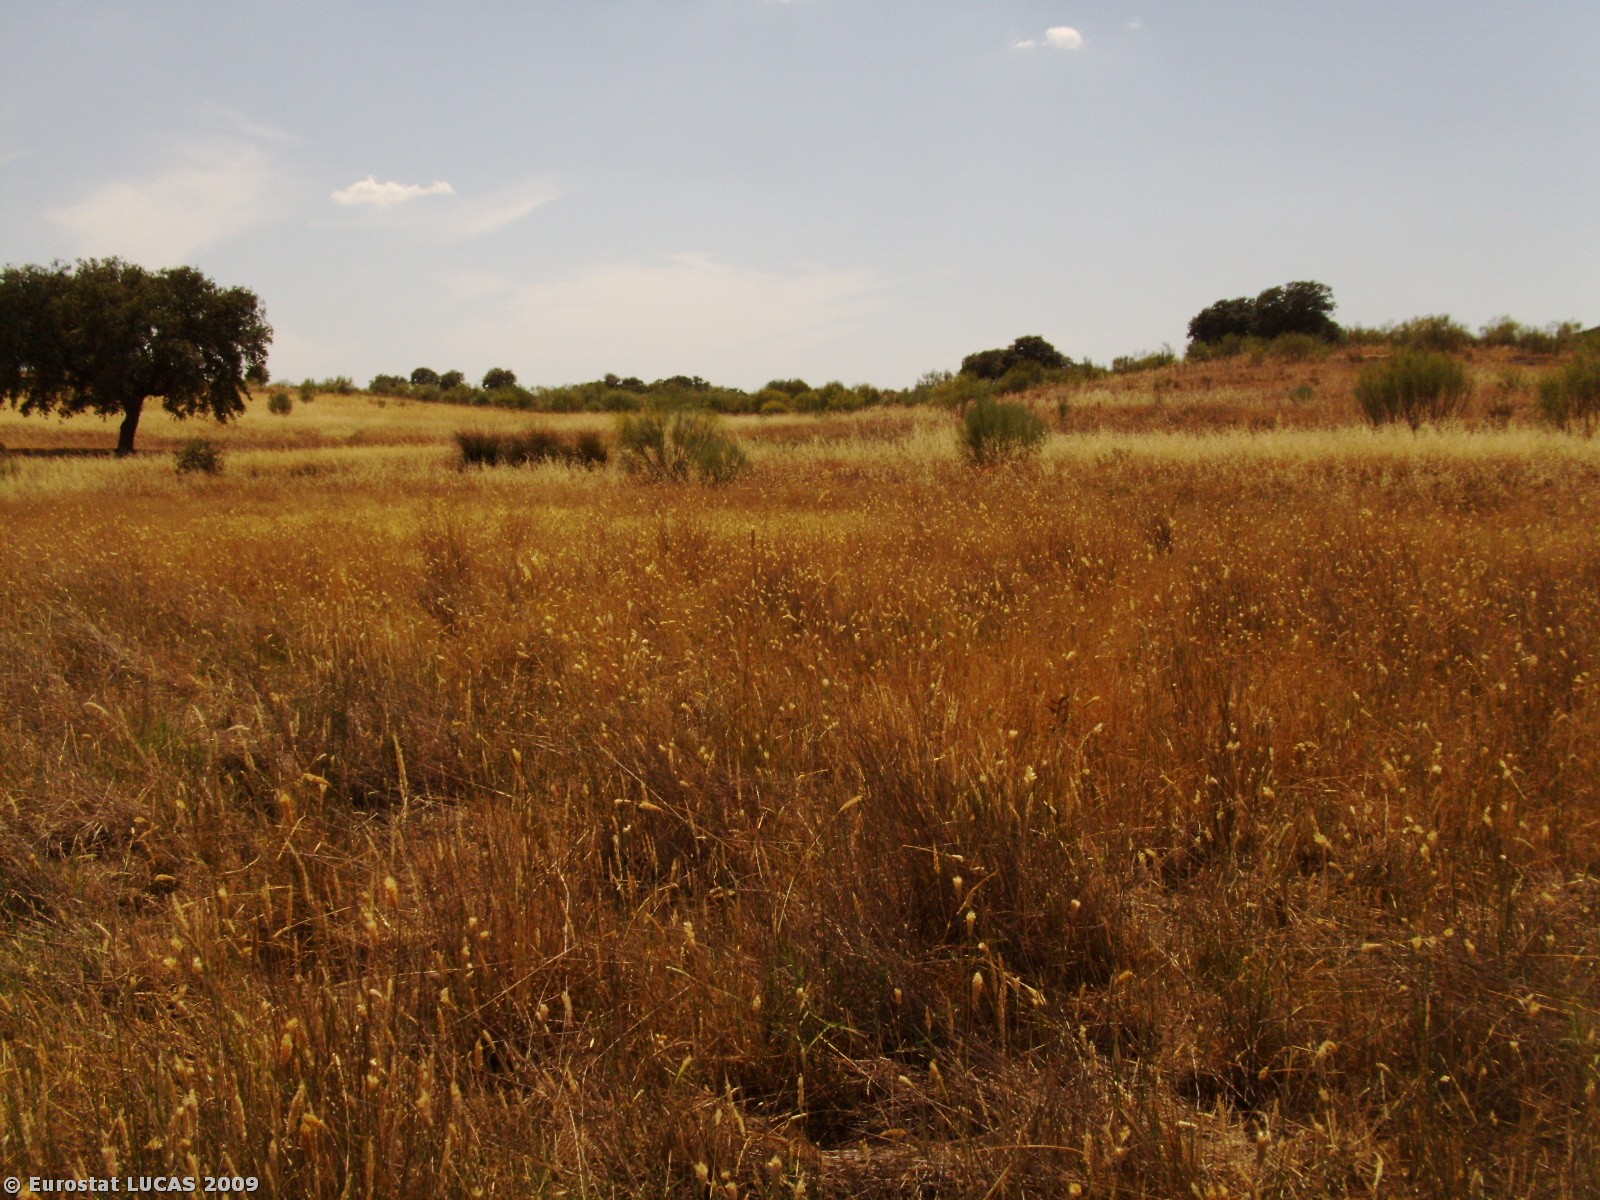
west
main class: Grassland
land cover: Spontaneously vegetated surfaces
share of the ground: > 75 %
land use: Fallow land
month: June
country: PT
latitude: 39.7737
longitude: -7.1708
